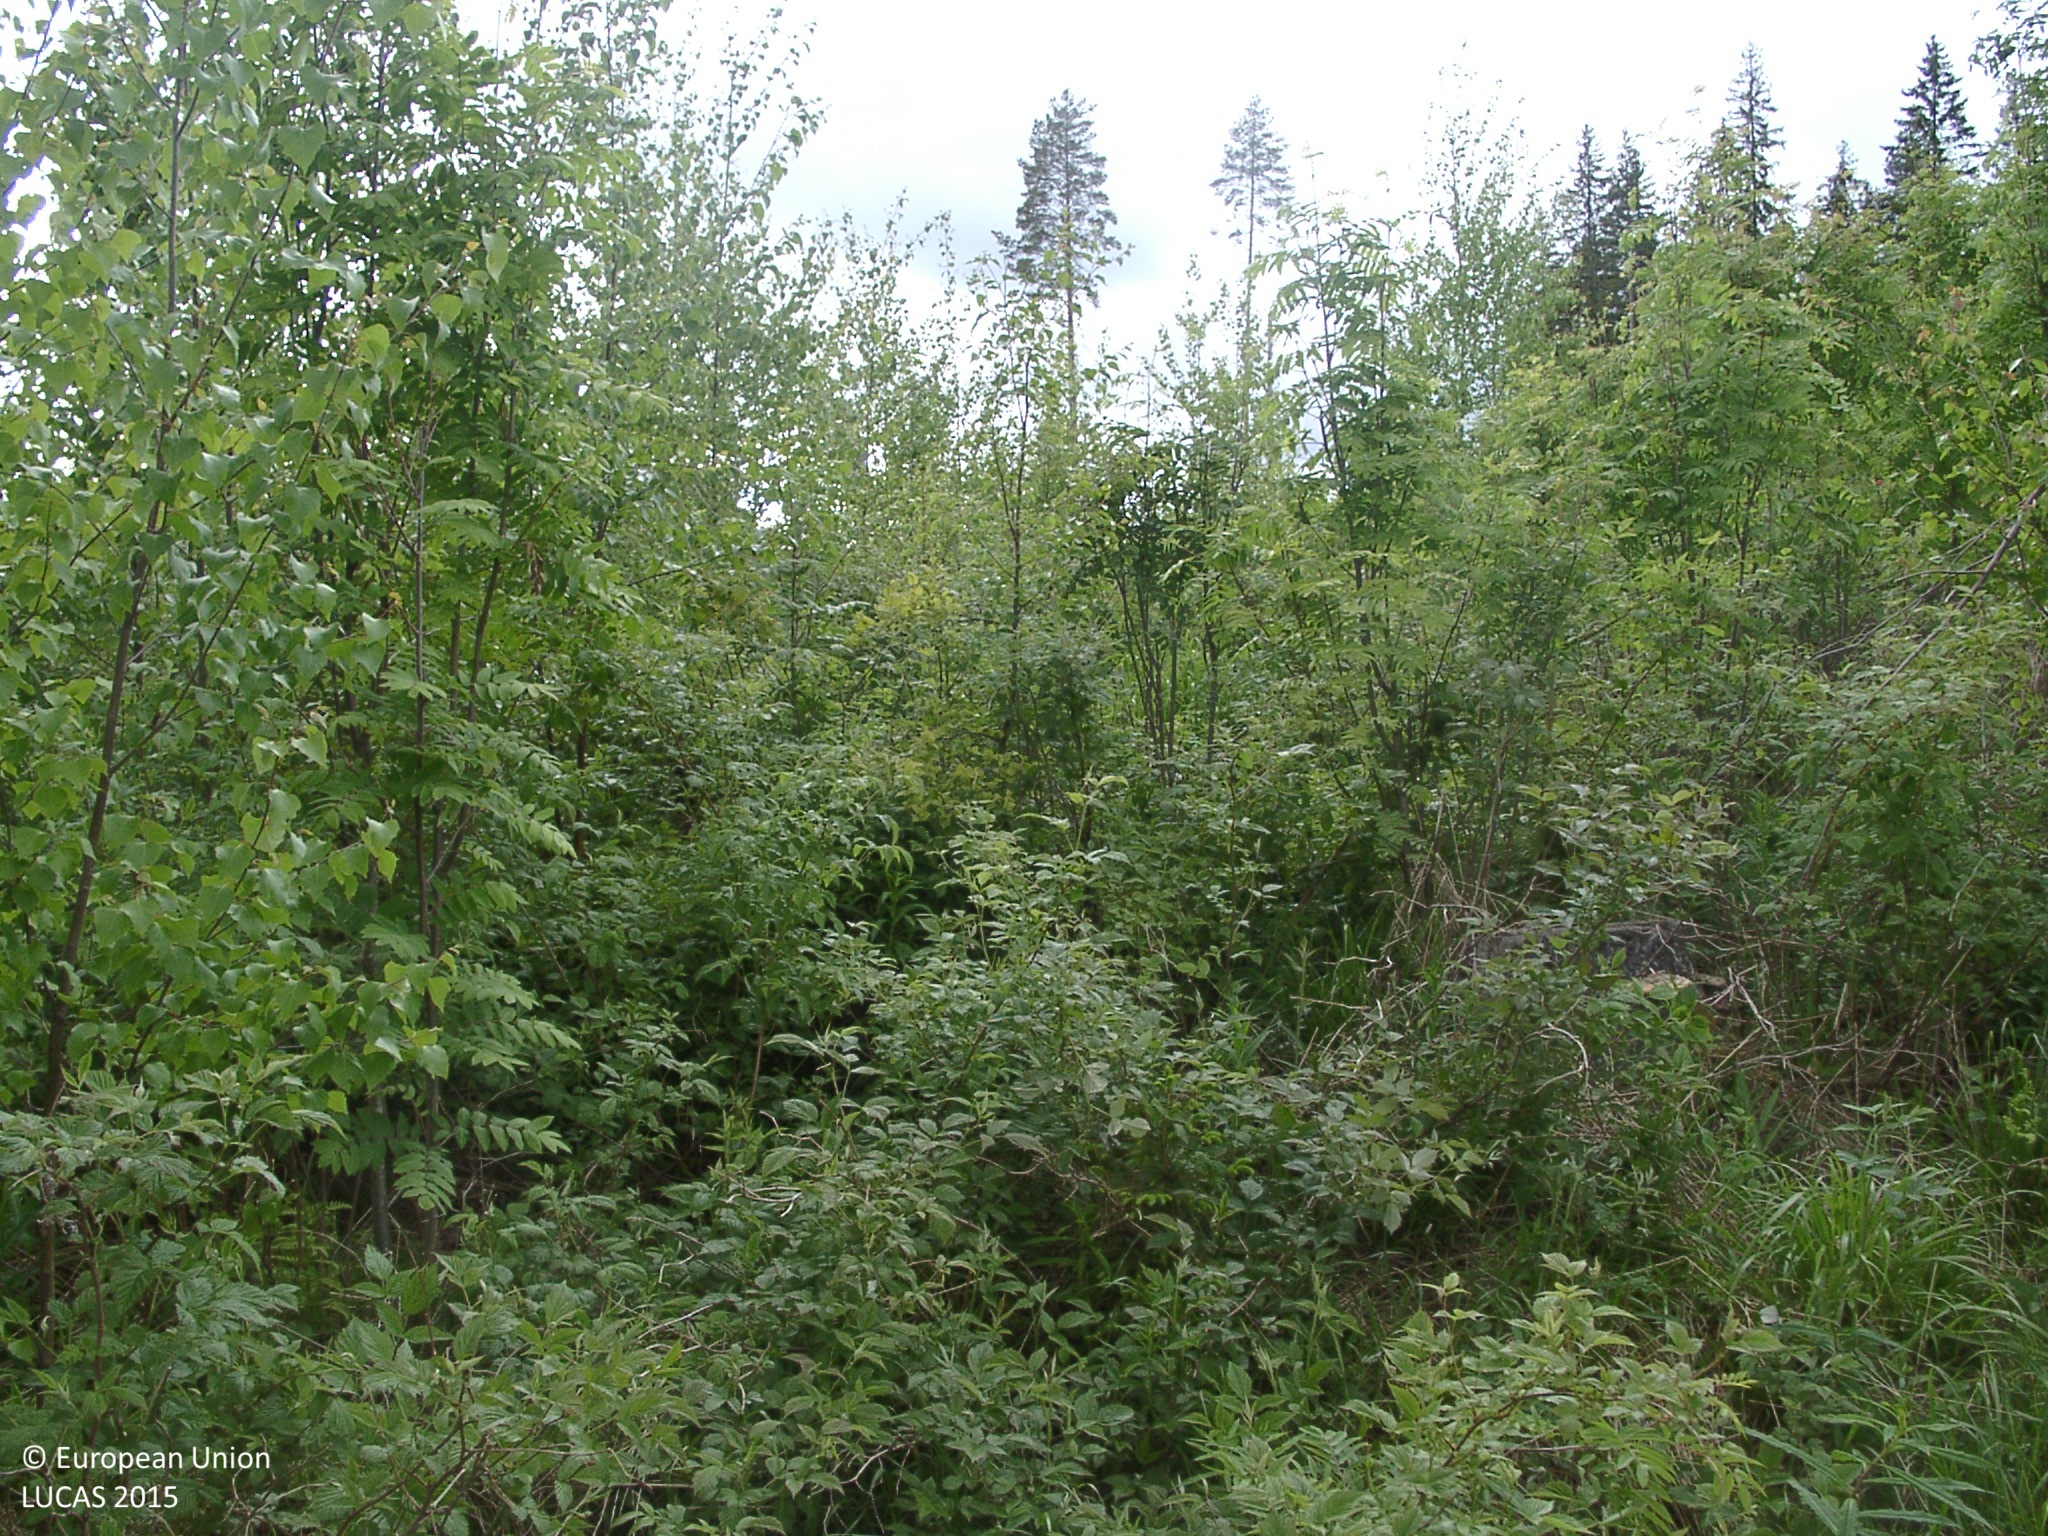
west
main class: Woodland
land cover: Spruce dominated mixed woodland
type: boreal forest
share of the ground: 50 - 75 %
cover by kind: broadleaved forest trees 45 %, coniferous forest trees 25 %, shrubs 15 %, herbaceous plants 15 %
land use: Forestry
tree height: < 5 m
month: June
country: FI
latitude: 62.4532
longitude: 25.7997
